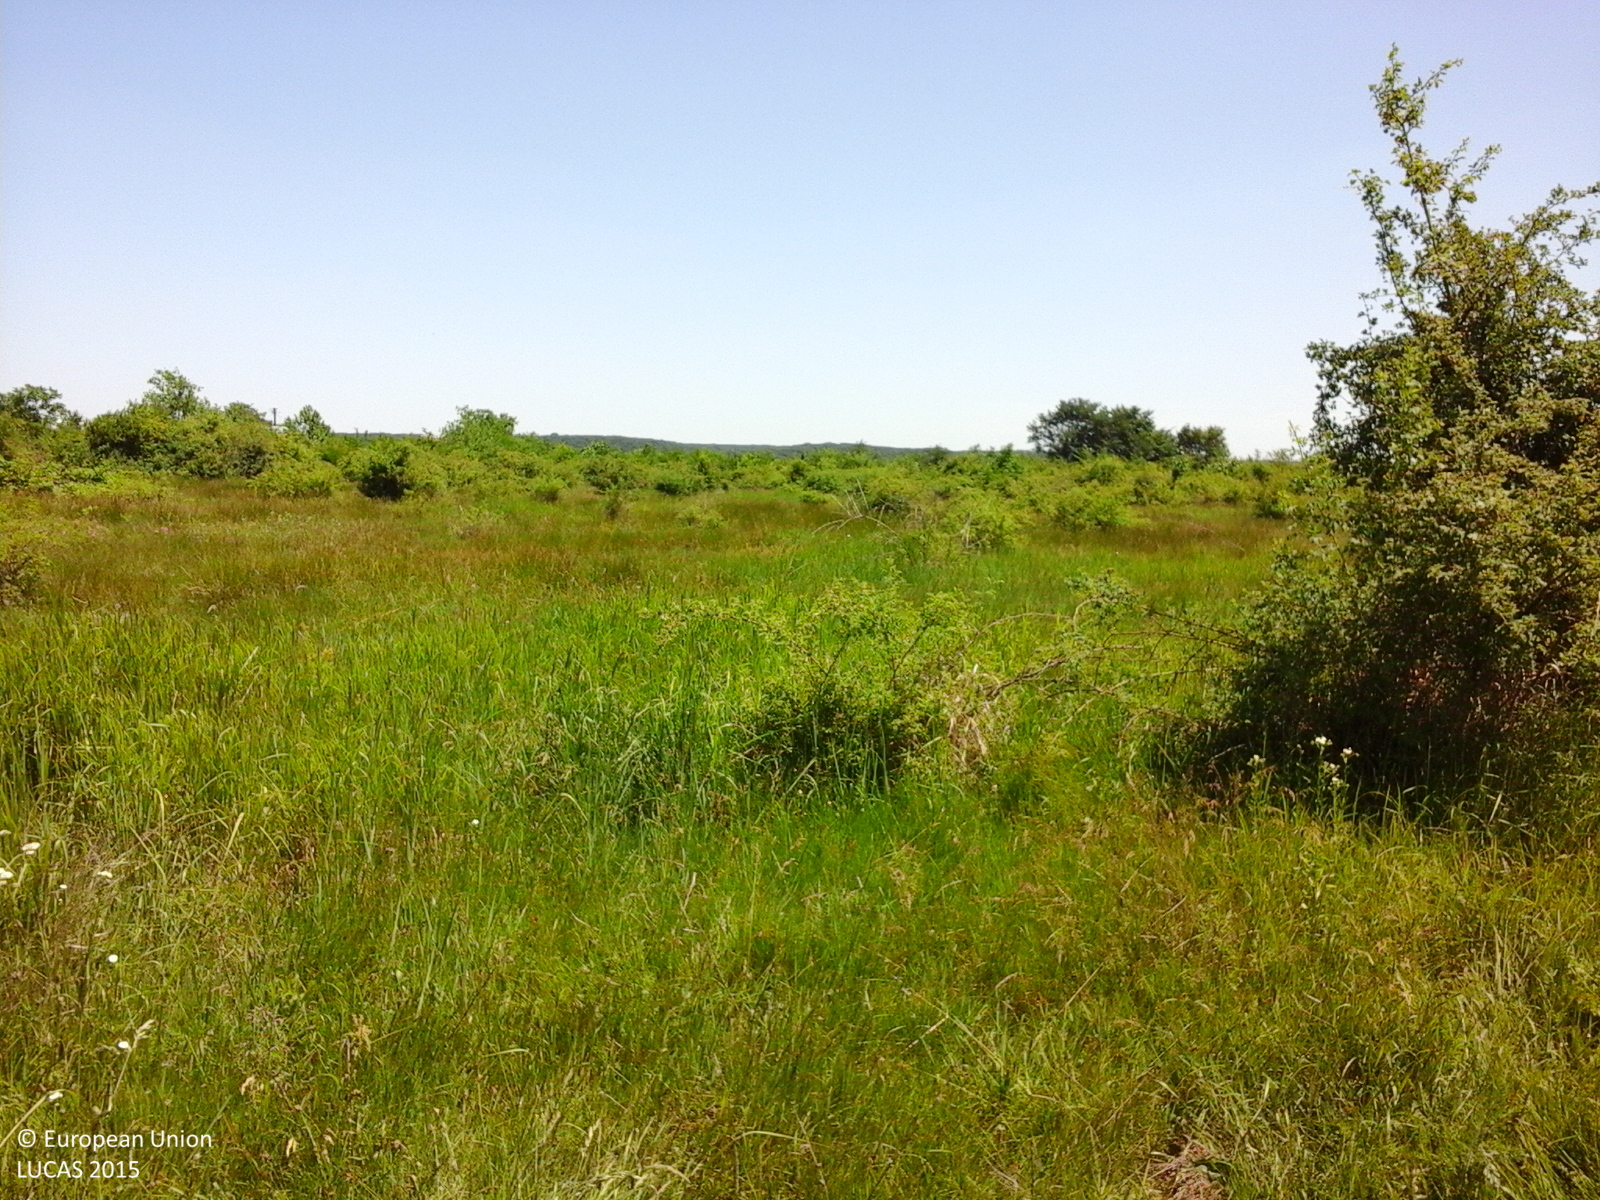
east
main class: Grassland
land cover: Grassland with sparse tree/shrub cover
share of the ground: > 75 %
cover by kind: herbaceous plants 85 %, shrubs 10 %, broadleaved forest trees 5 %
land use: Agriculture (excluding fallow land and kitchen gardens)
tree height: < 5 m
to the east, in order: Grassland with sparse tree/shrub cover; Abandoned hedges; Tracks; Abandoned hedges; Grassland with sparse tree/shrub cover; Fences; Grassland without tree/shrub cover; Abandoned hedges; Paved roads, cycling and walking lanes; Grass margins; Fences; Other leguminous and mixtures for fodder; Artificial constructions in urban areas; Other leguminous and mixtures for fodder; Managed hedges; Arable land (only in case pi)
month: June
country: RO
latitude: 44.9302
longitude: 25.6718
